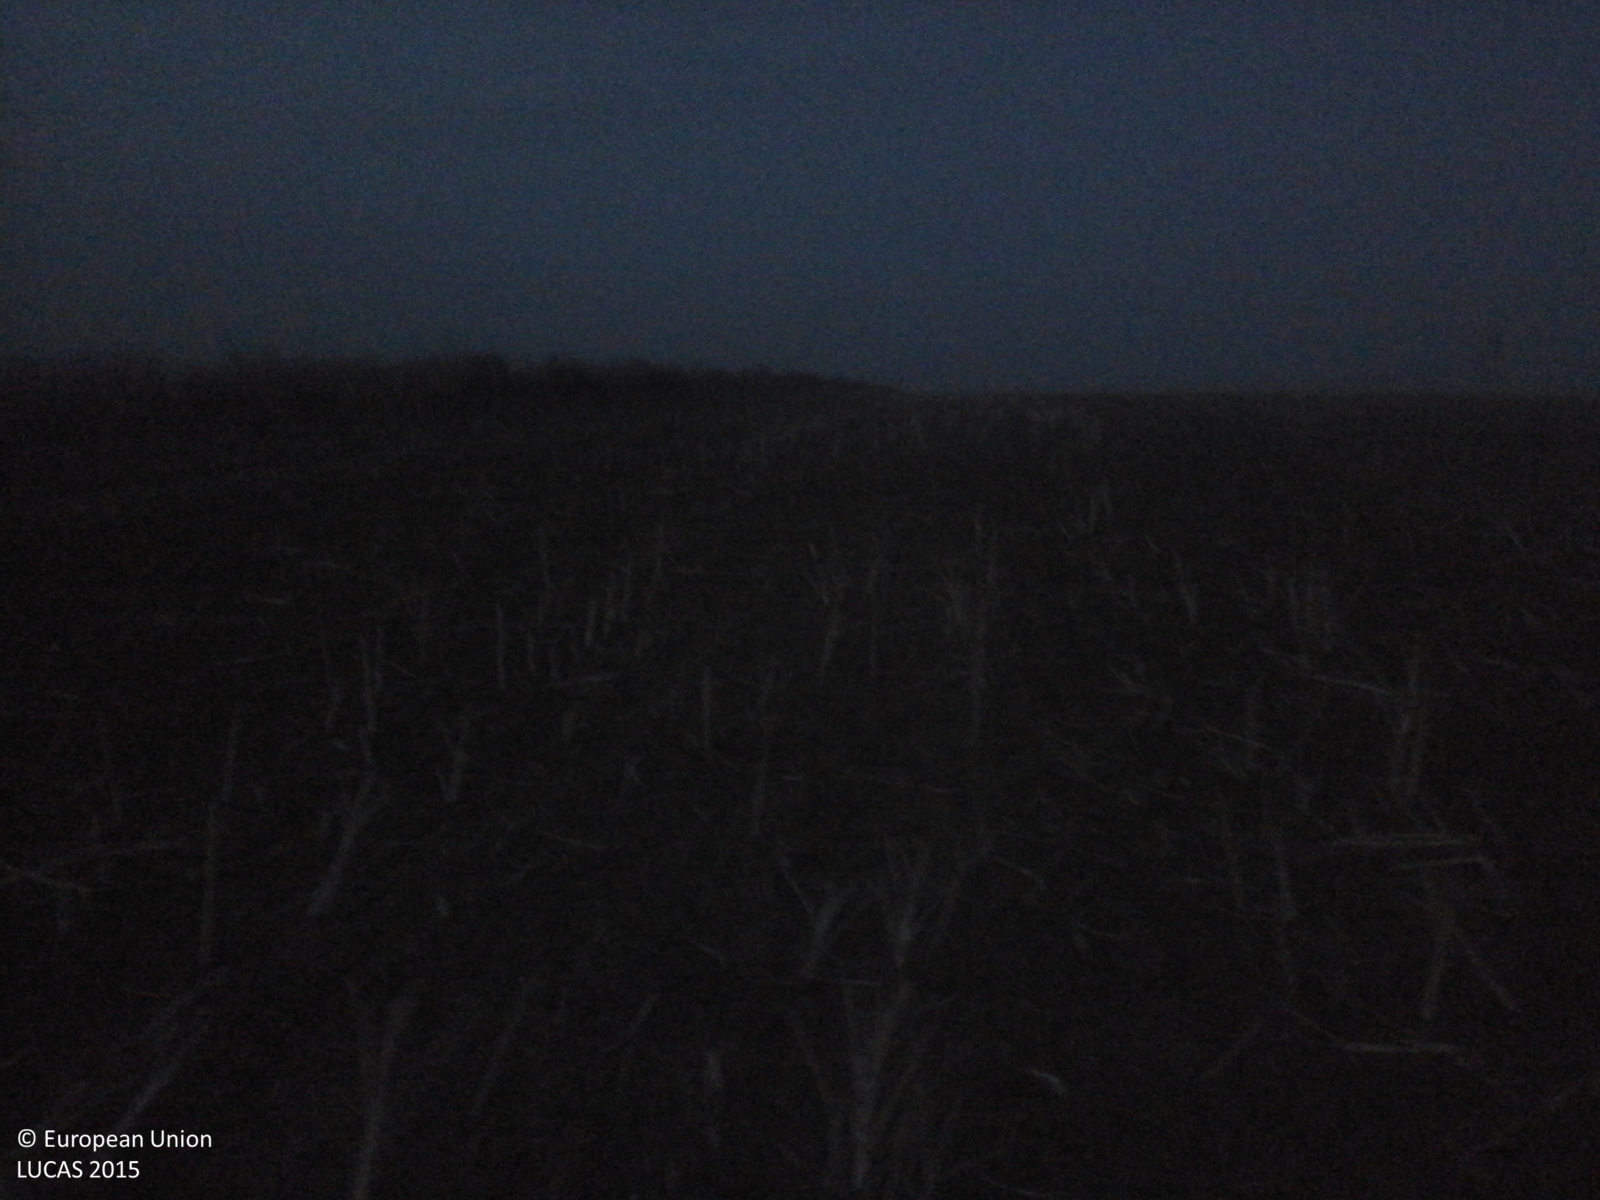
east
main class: Cropland
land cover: Rape and turnip rape
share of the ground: 25 - 50 %
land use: Agriculture (excluding fallow land and kitchen gardens)
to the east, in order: Rape and turnip rape; Grass margins; Tracks; Grass margins; Common wheat
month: August
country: RO
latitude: 44.1496
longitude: 28.0718
